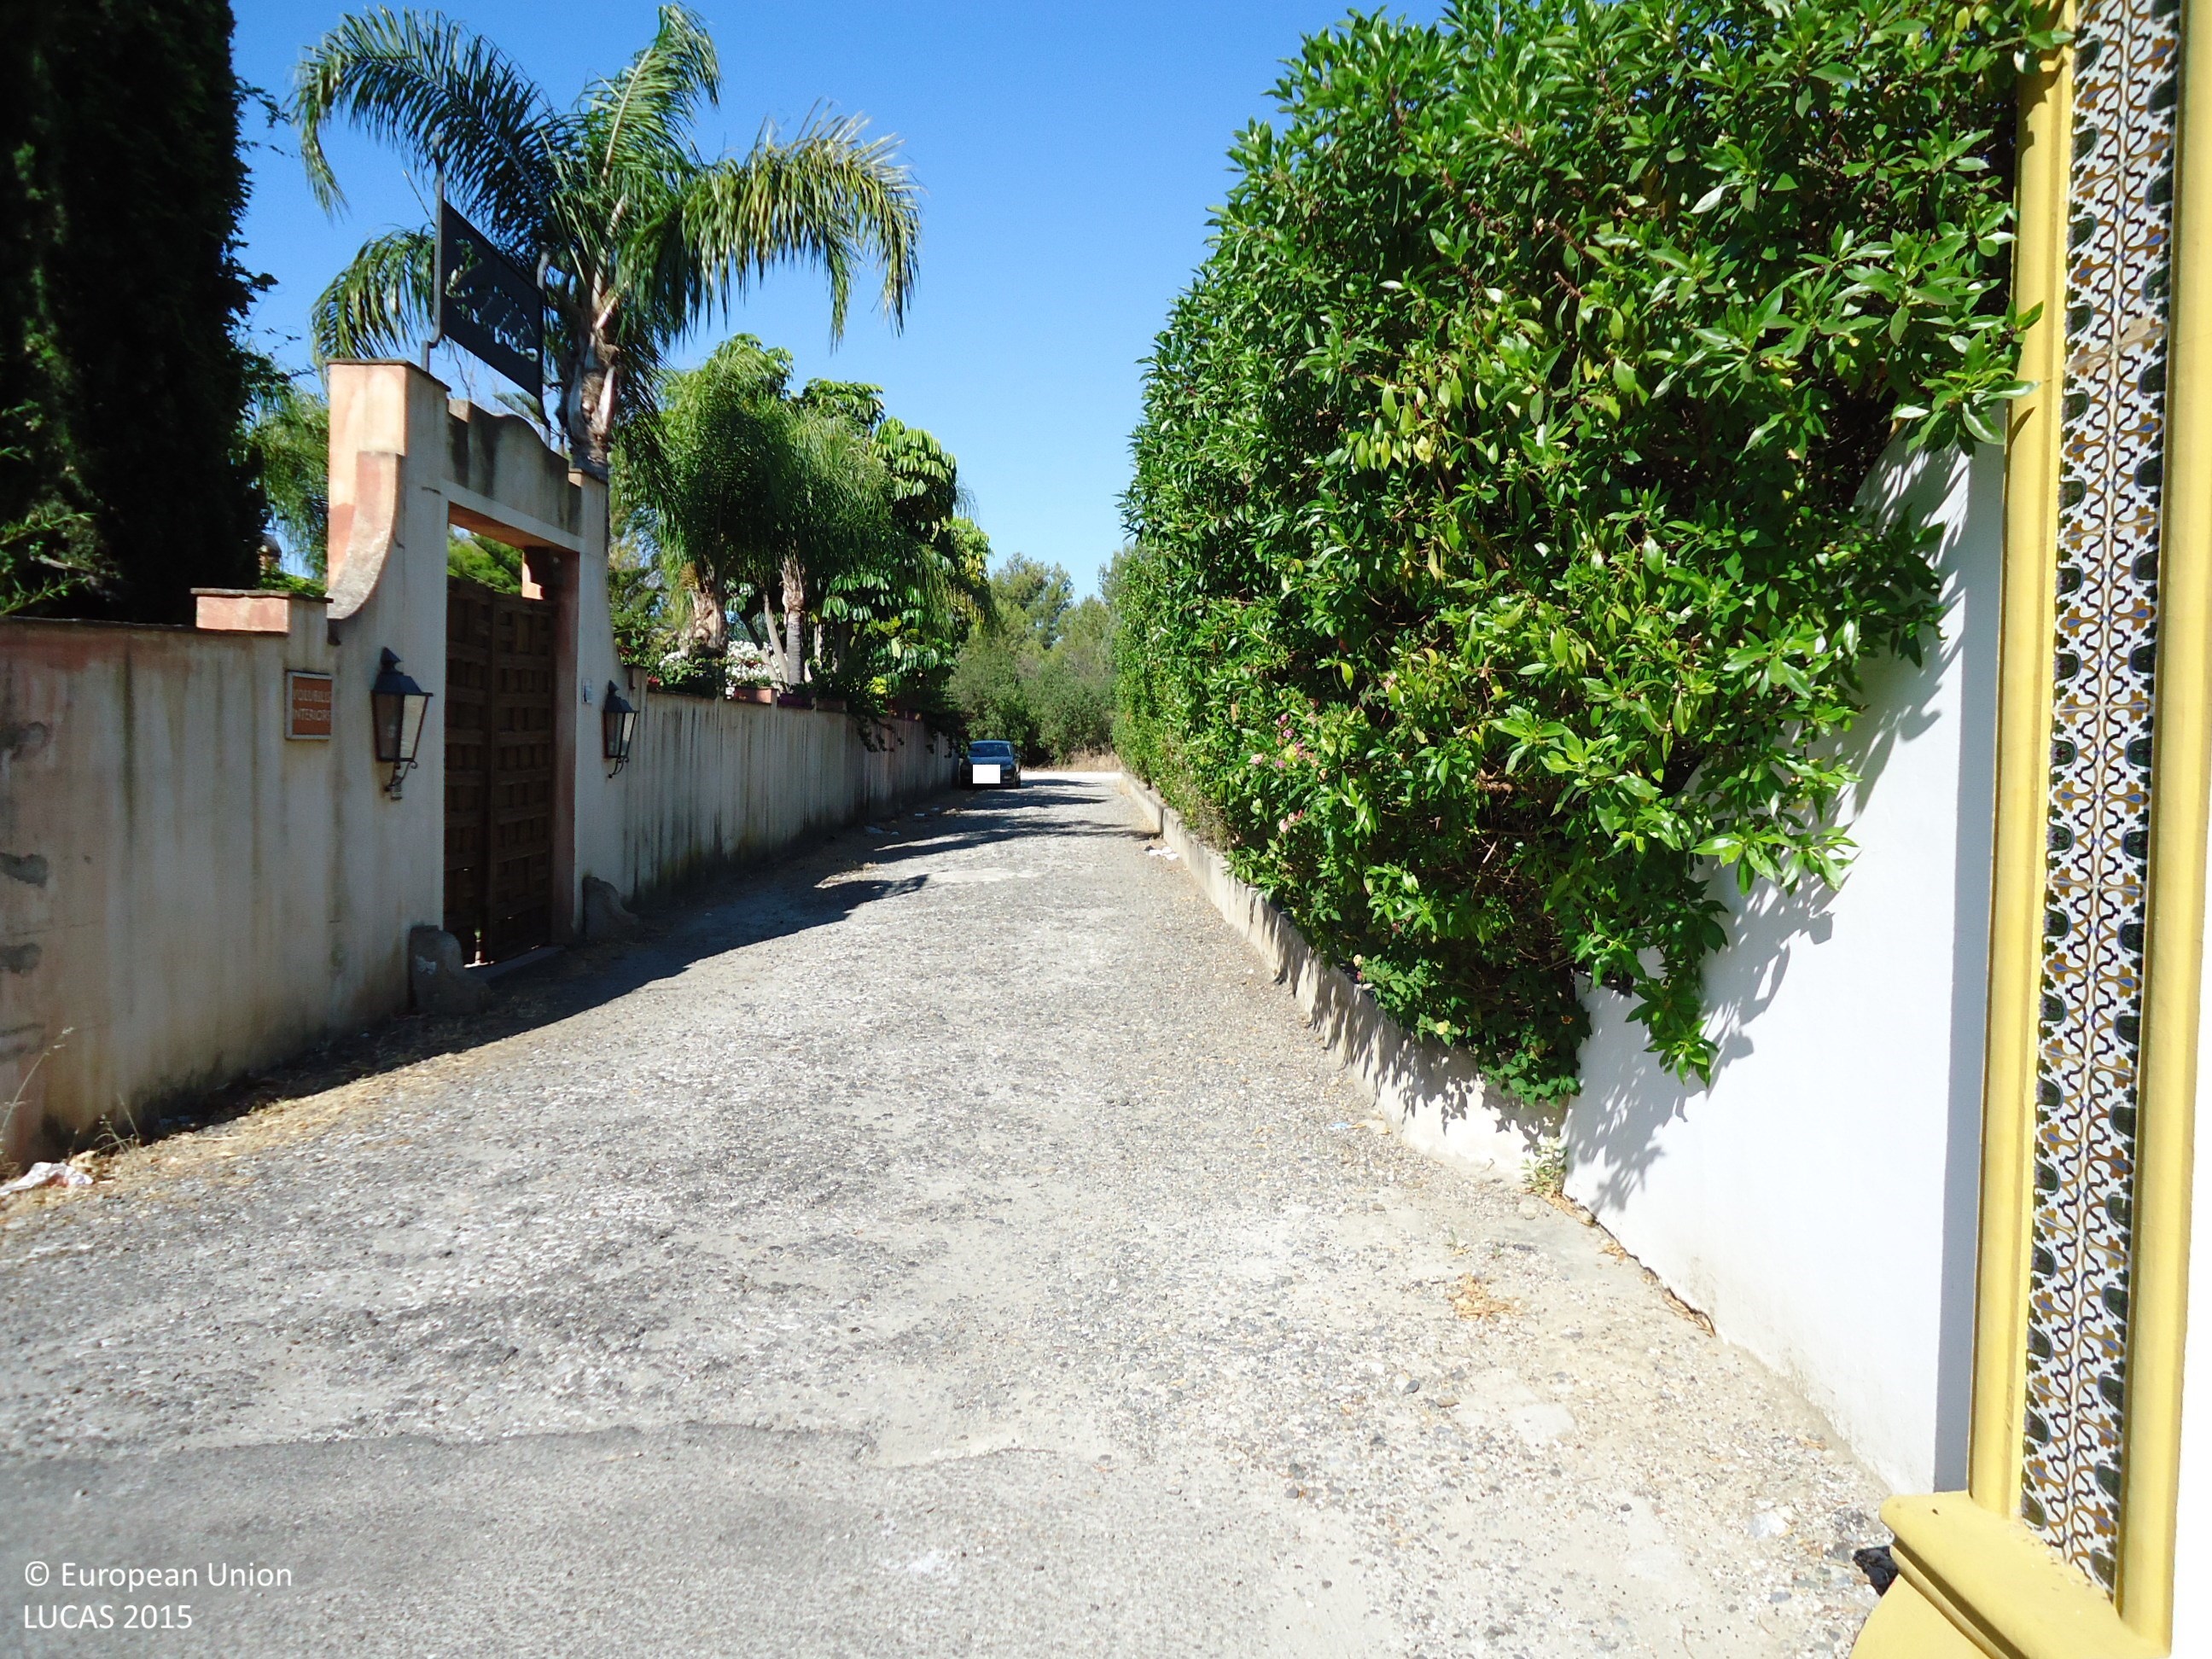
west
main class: Woodland
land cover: Broadleaved woodland
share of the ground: 25 - 50 %
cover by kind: herbaceous plants 70 %, broadleaved forest trees 30 %
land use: Residential
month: June
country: ES
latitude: 36.5081
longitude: -4.9200
